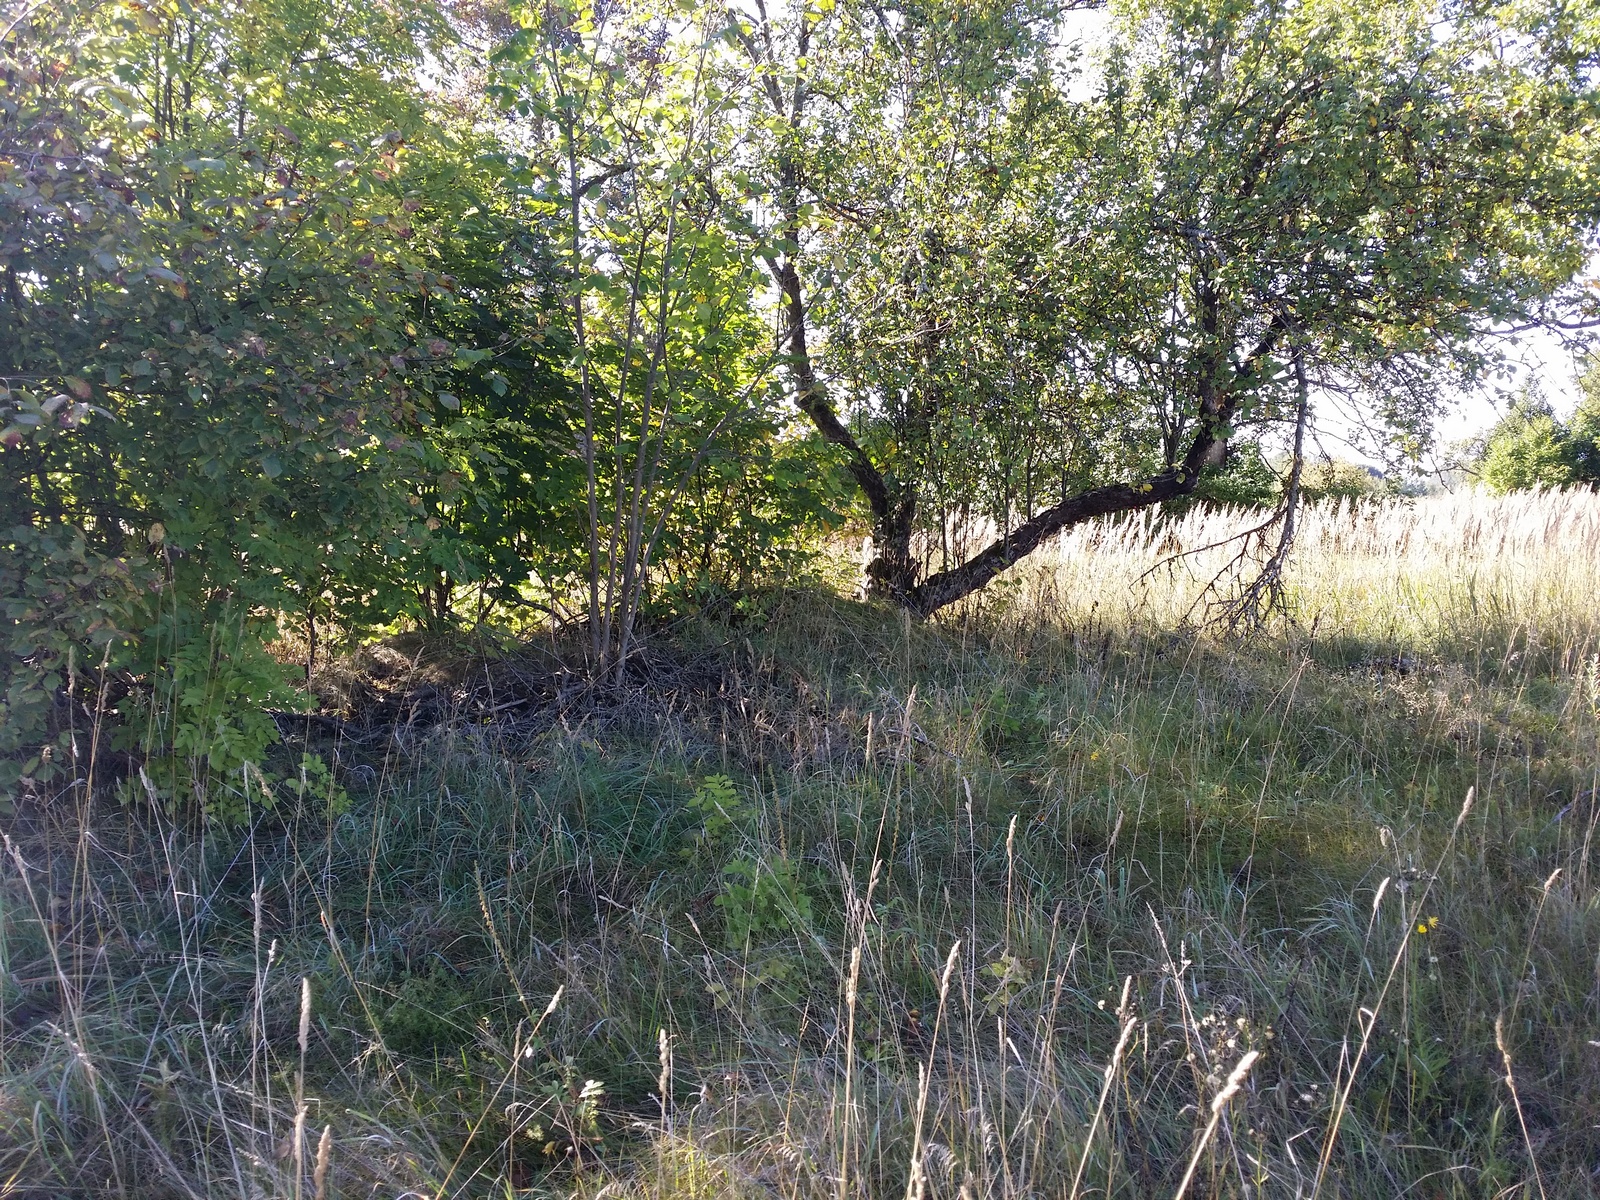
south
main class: Grassland
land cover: Grassland without tree/shrub cover
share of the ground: > 75 %
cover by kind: herbaceous plants 100 %
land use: Agriculture (excluding fallow land and kitchen gardens)
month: September
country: LV
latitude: 57.1731
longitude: 27.5952
